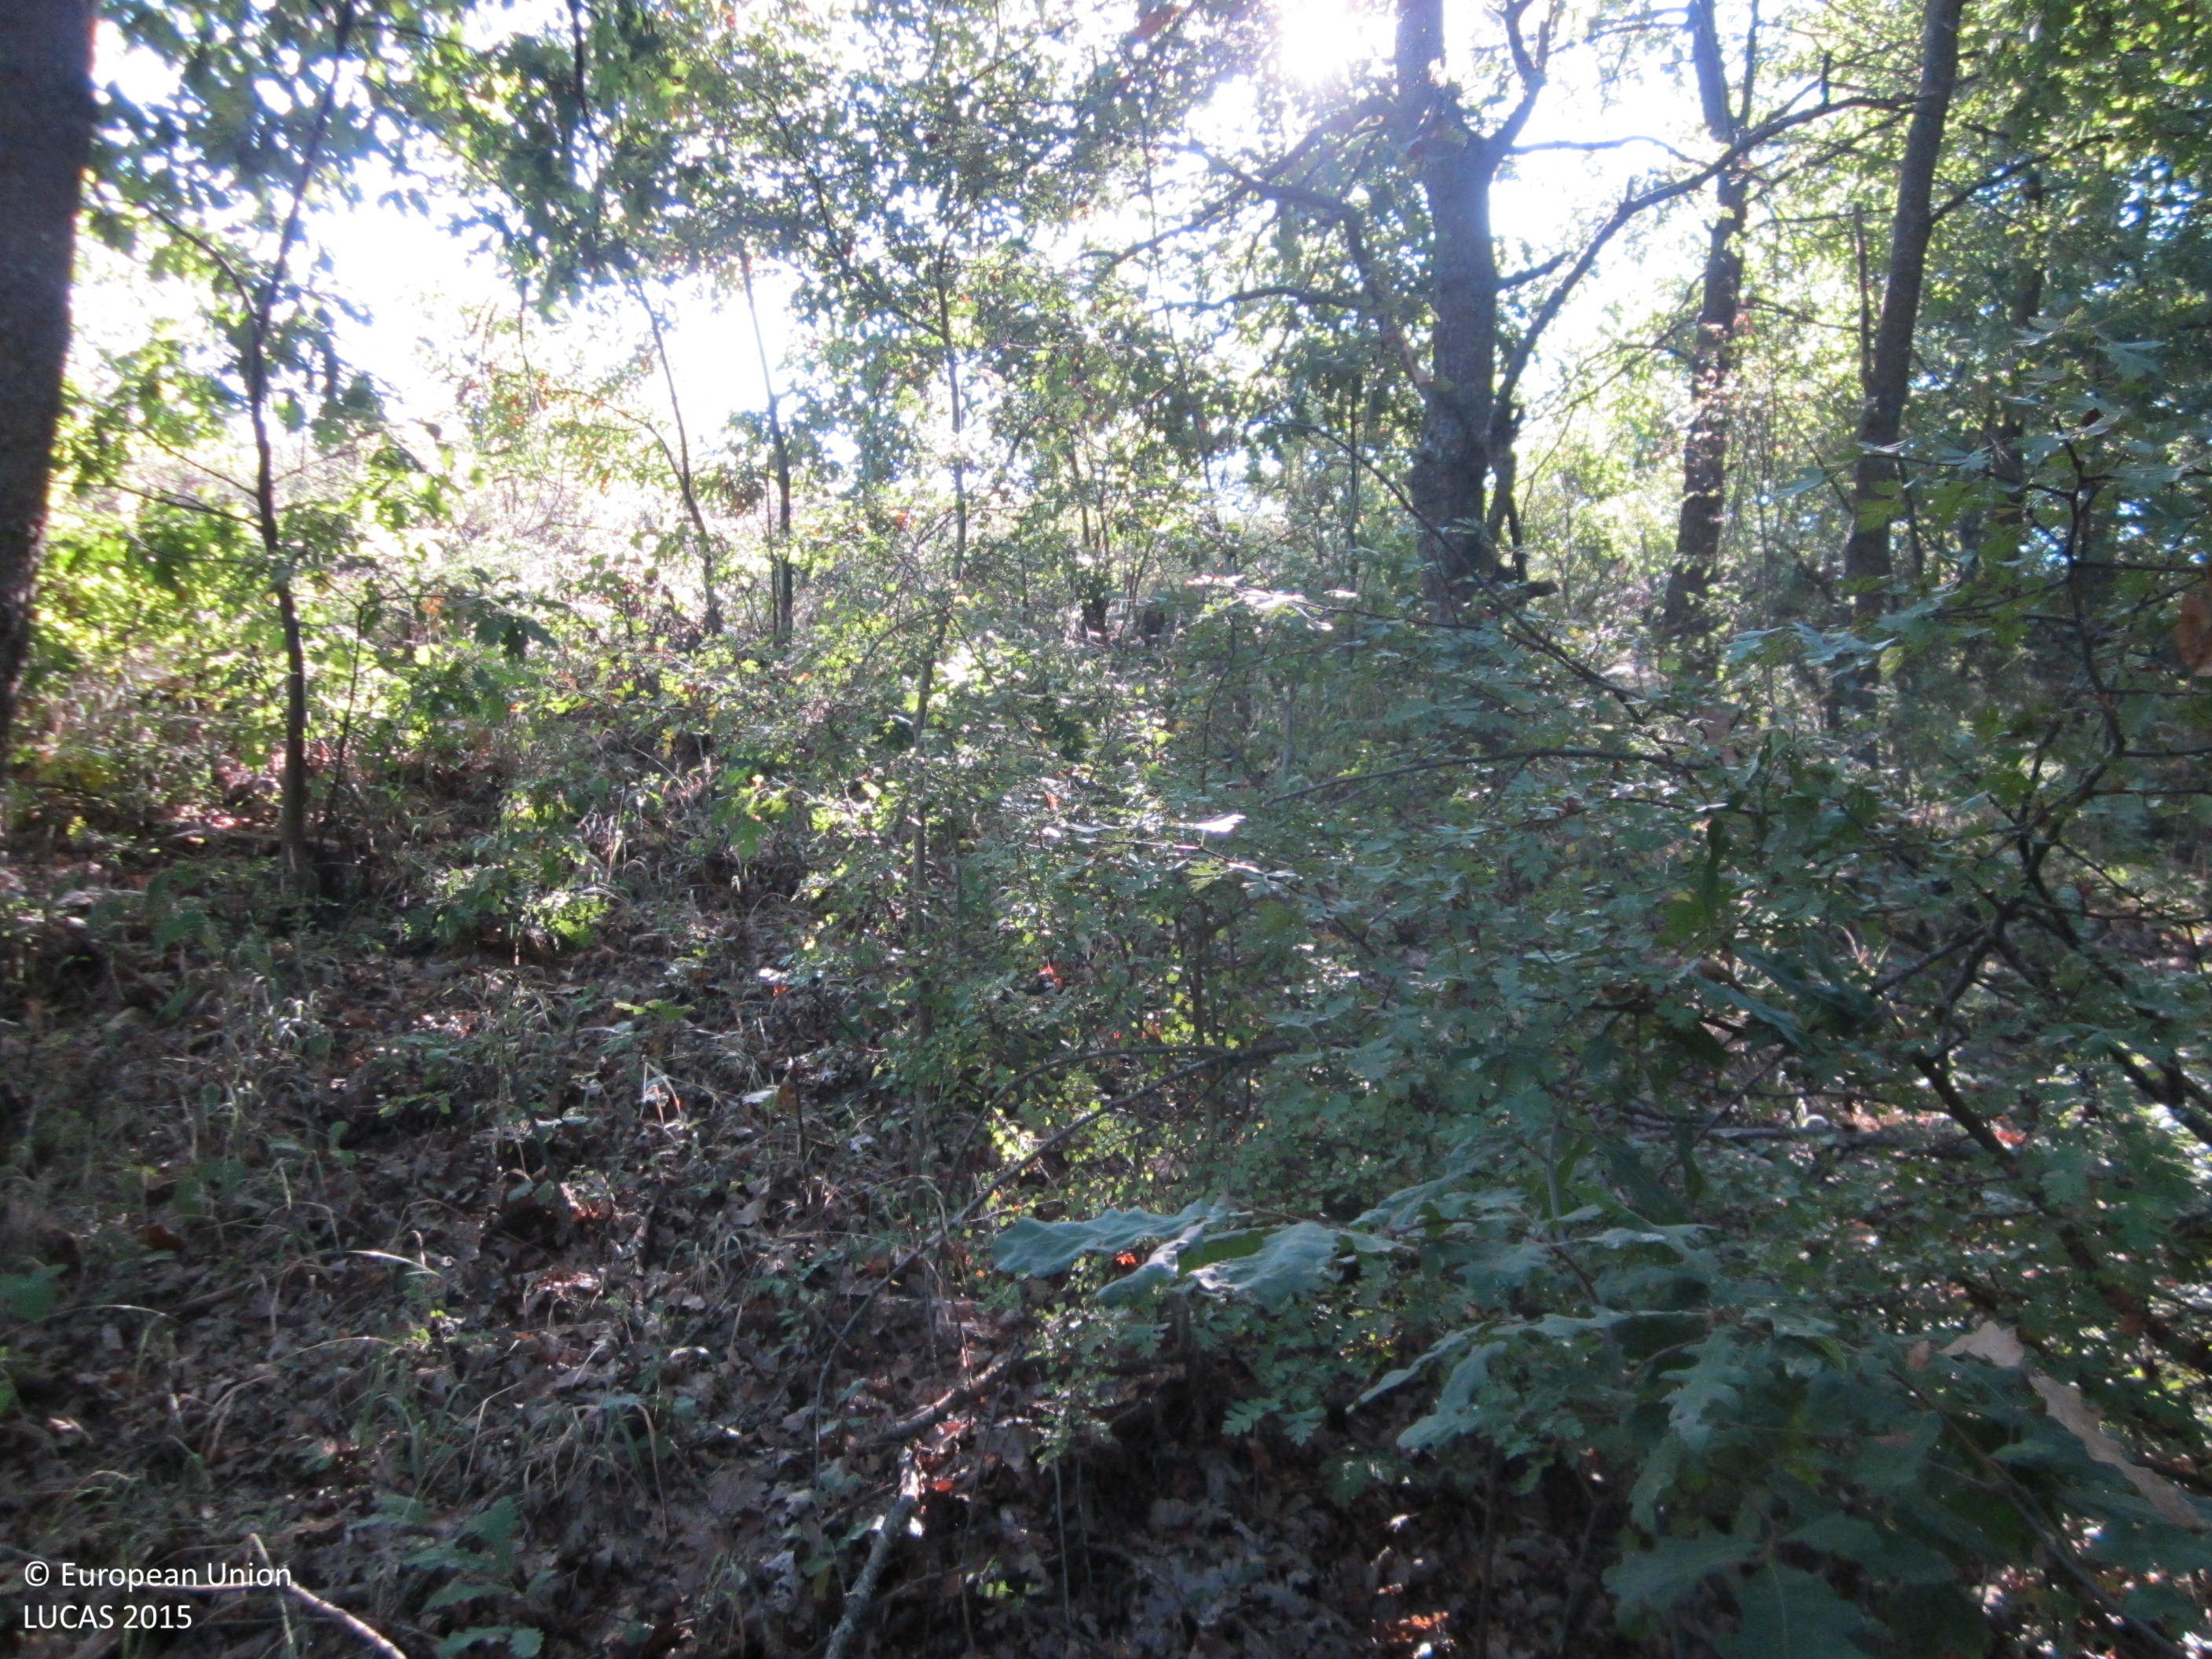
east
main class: Woodland
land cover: Broadleaved woodland
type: thermophilous deciduous forest
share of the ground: > 75 %
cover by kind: broadleaved forest trees 90 %, shrubs 5 %, herbaceous plants 5 %
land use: Forestry
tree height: > 5 m
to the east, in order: Broadleaved woodland; Grassland without tree/shrub cover; Broadleaved woodland; Grassland with sparse tree/shrub cover; Broadleaved woodland; Grassland with sparse tree/shrub cover; Broadleaved woodland; Grass margins; Tracks
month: September
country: BG
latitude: 42.1876
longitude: 27.0660
